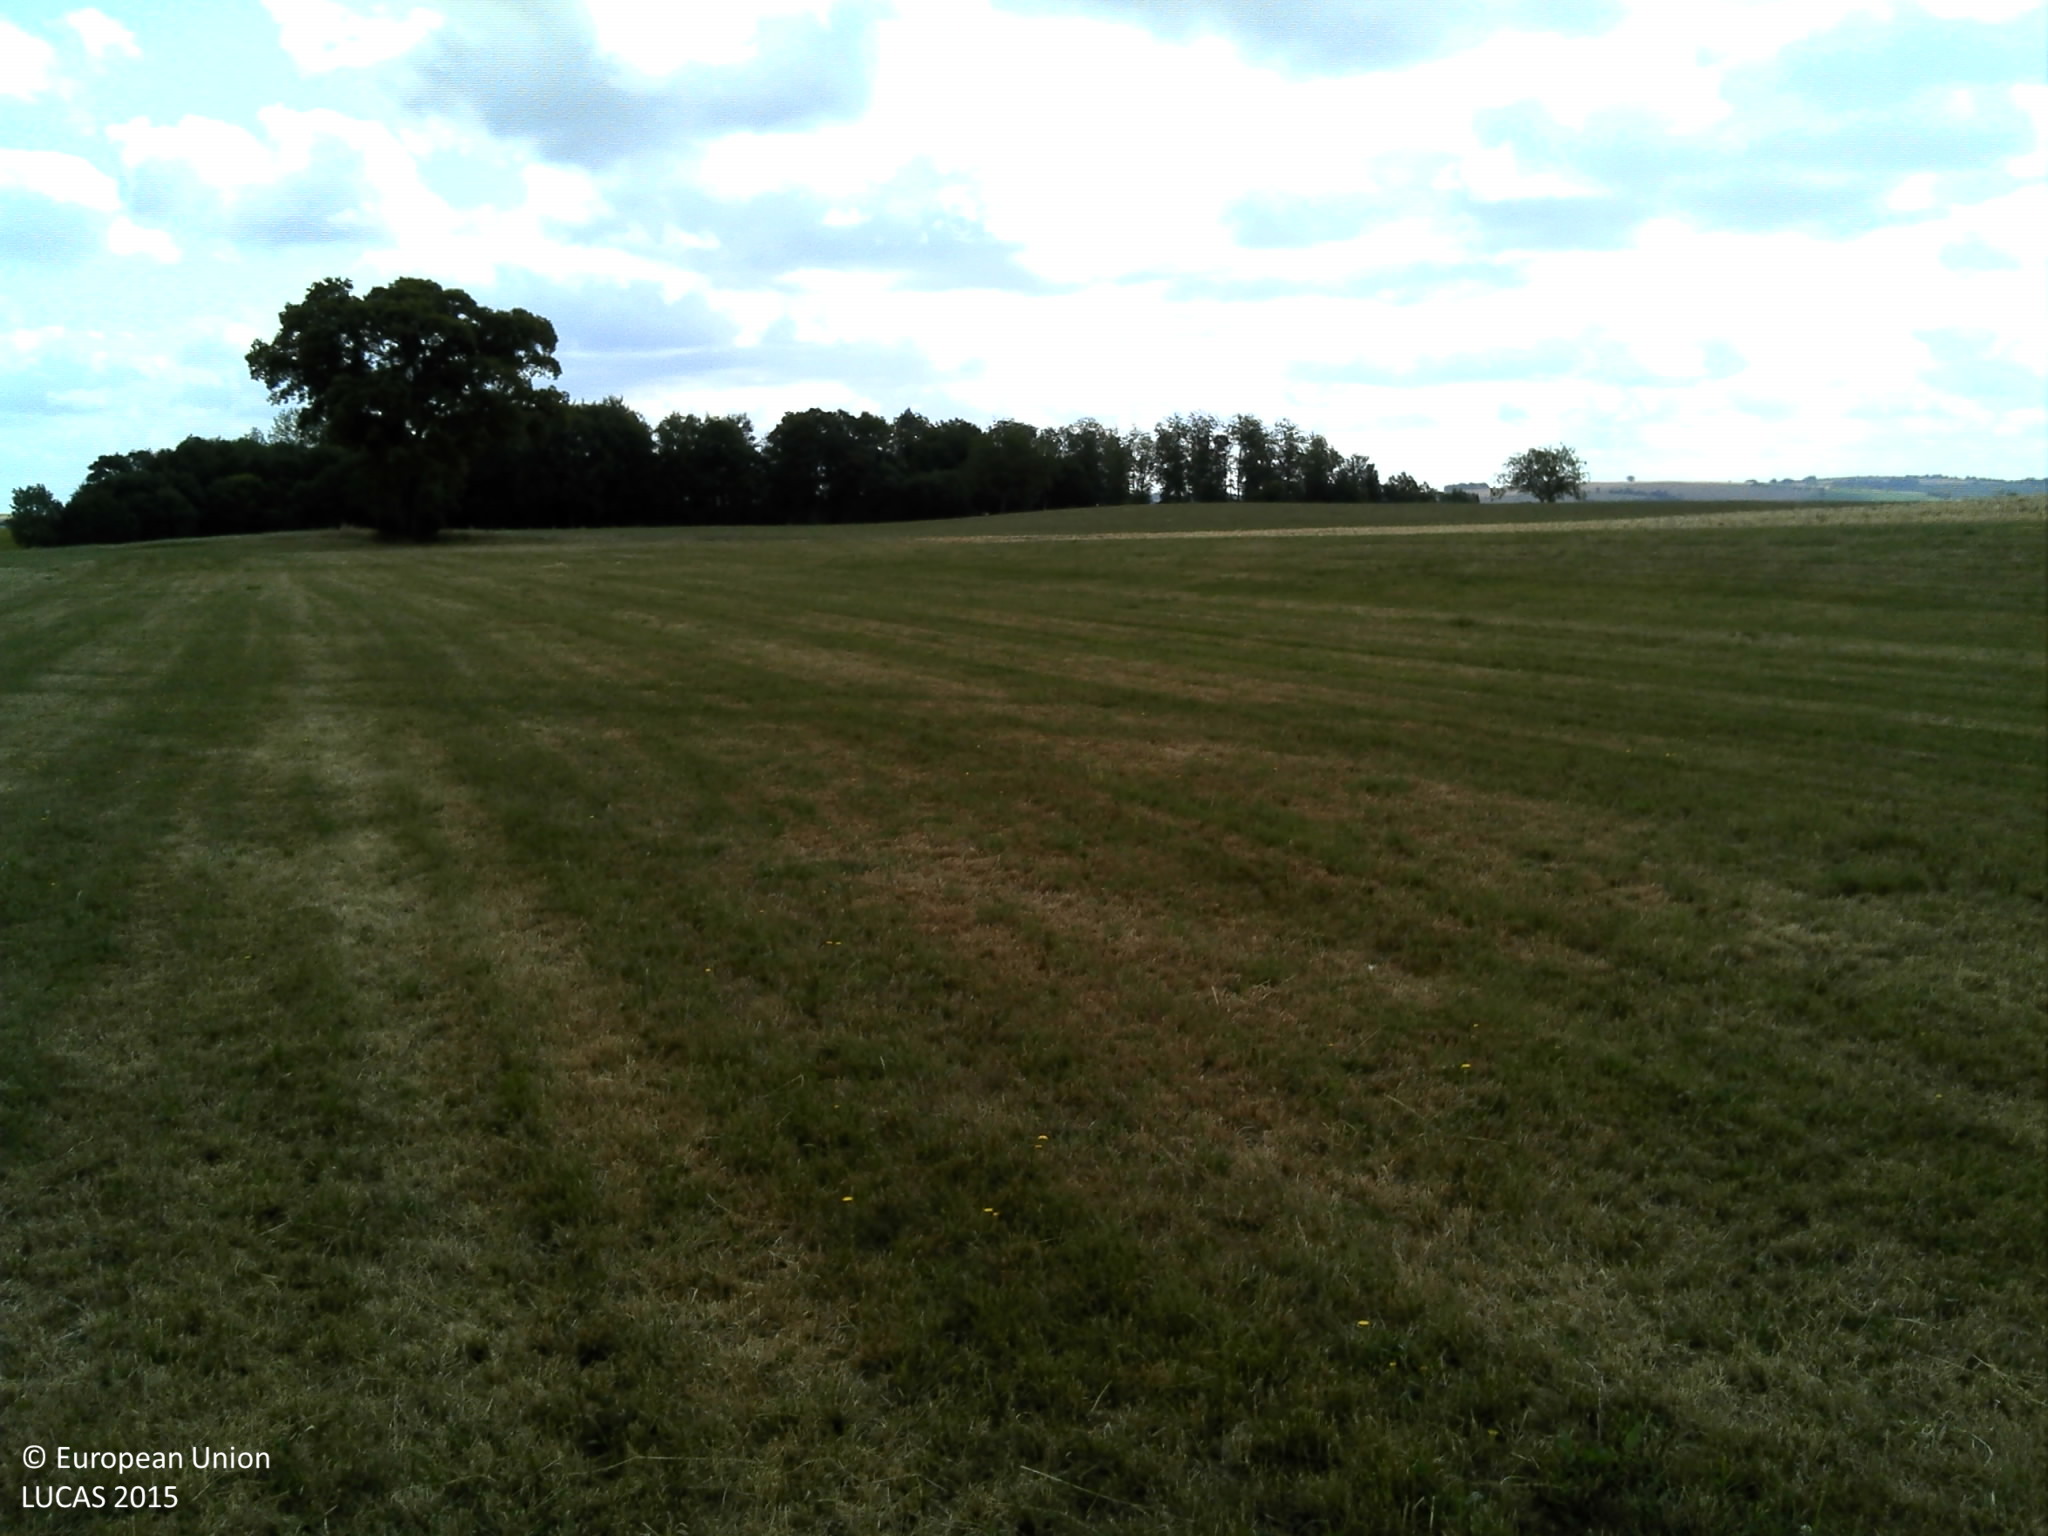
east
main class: Grassland
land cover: Grassland without tree/shrub cover
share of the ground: > 75 %
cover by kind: herbaceous plants 100 %
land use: Agriculture (excluding fallow land and kitchen gardens)
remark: Harvested field
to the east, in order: Grassland without tree/shrub cover; Other bare soil; Grassland without tree/shrub cover
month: July
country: FR
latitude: 48.1759
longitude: 6.1947
